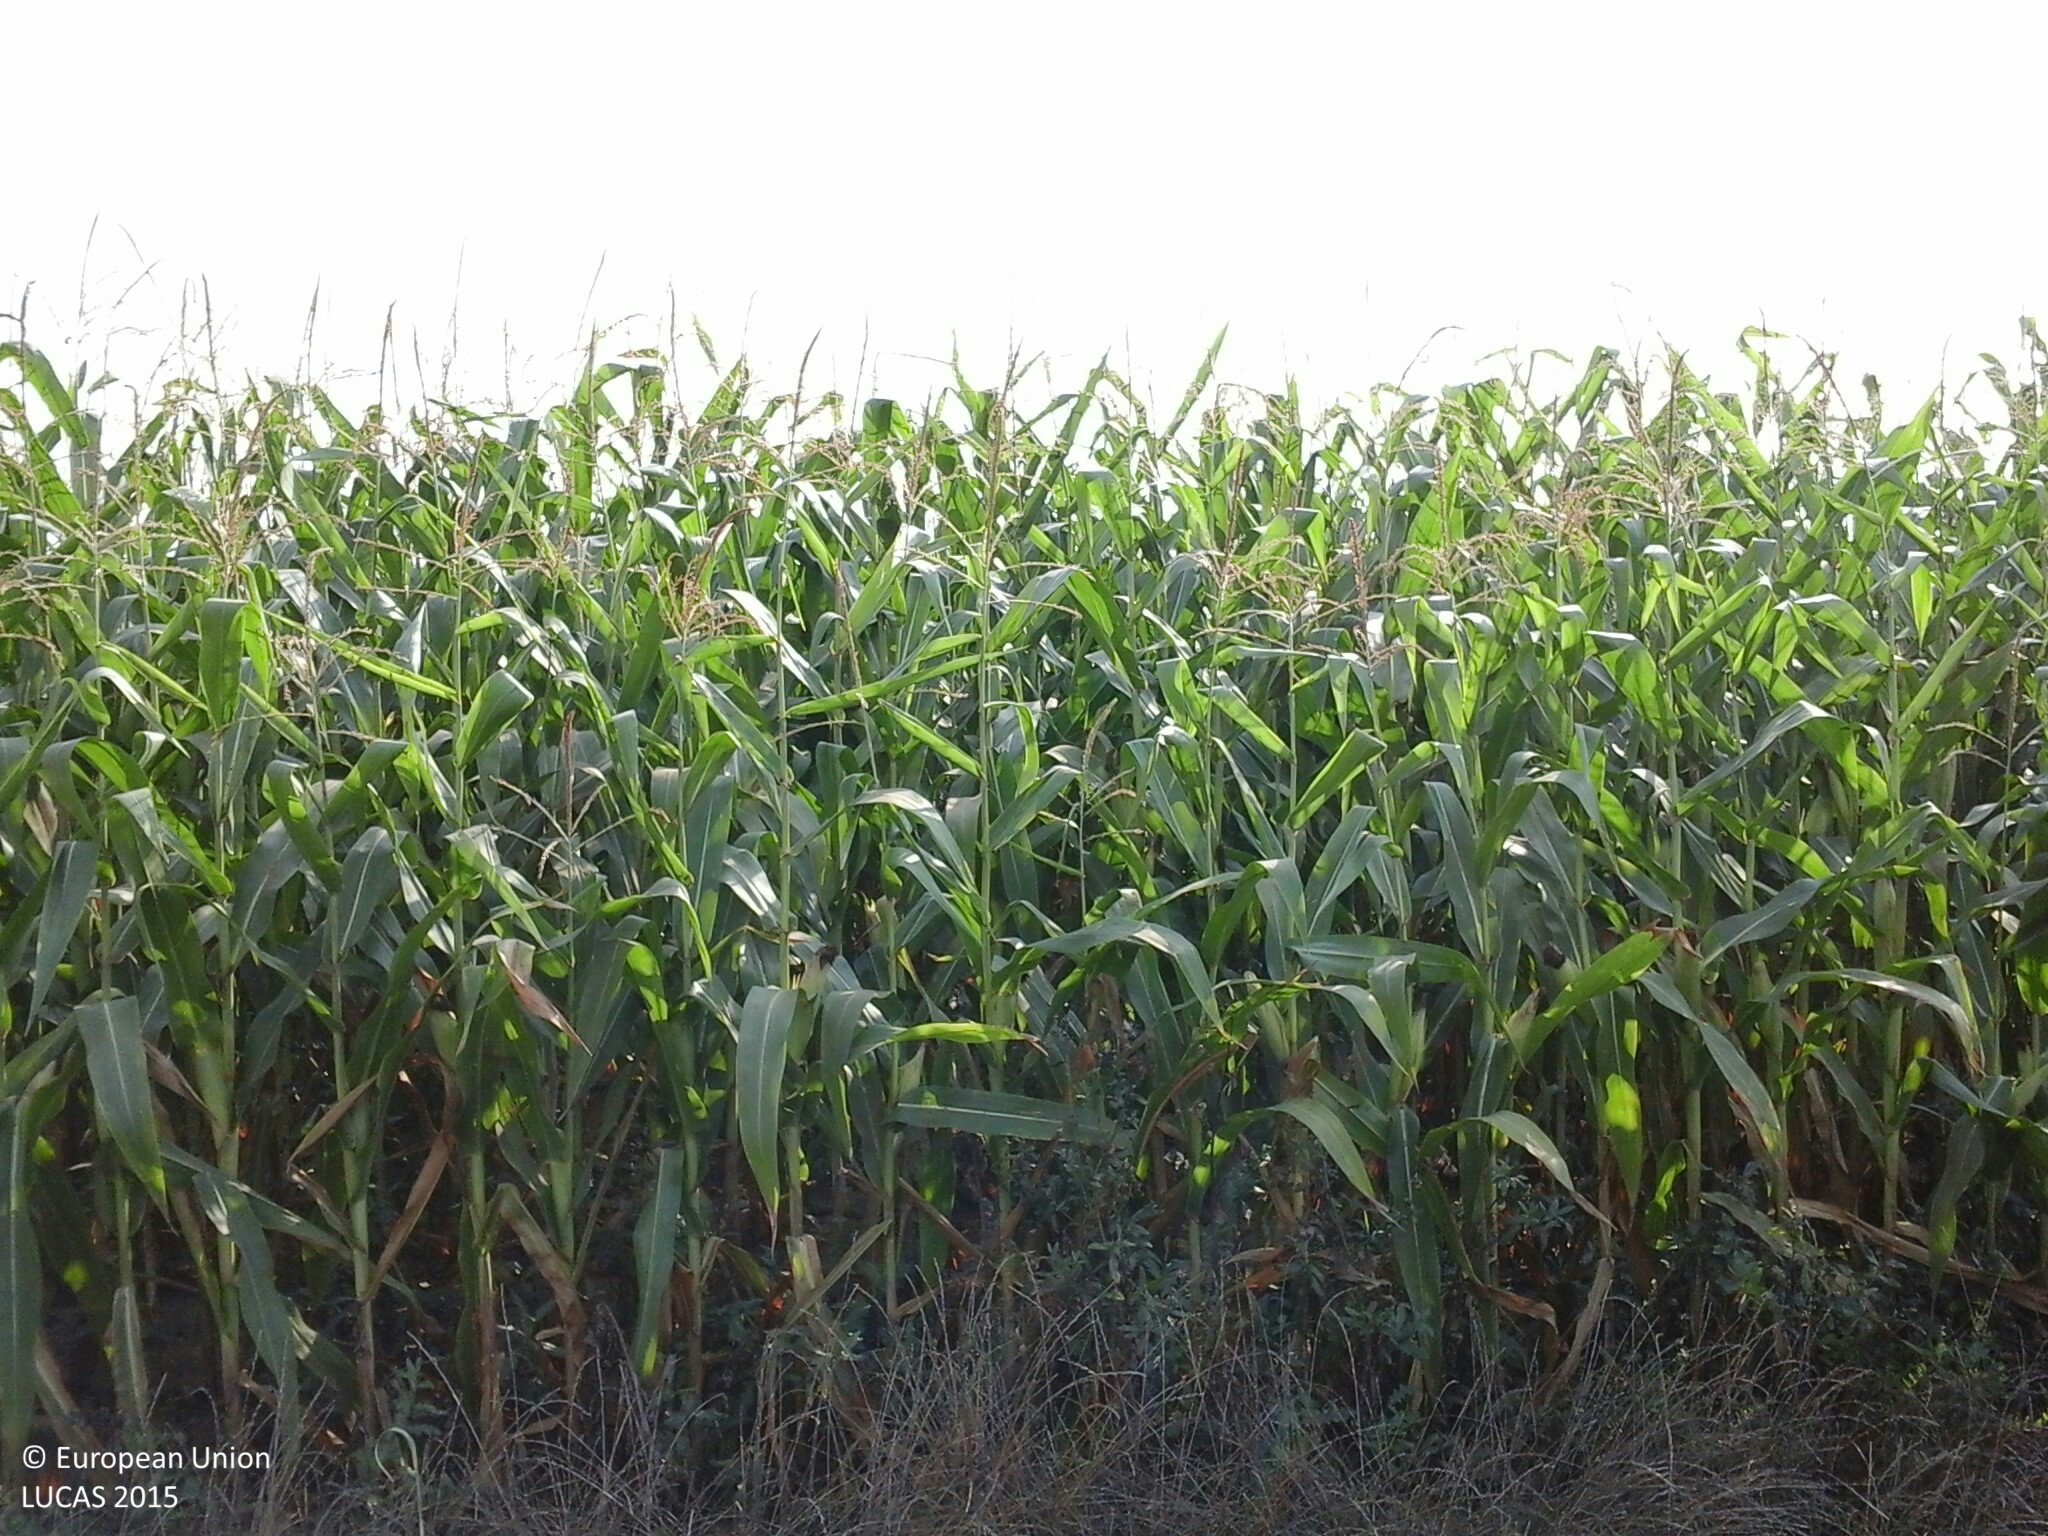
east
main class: Cropland
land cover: Maize
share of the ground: > 75 %
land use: Agriculture (excluding fallow land and kitchen gardens)
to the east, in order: Maize; Grass margins; Tracks; Maize
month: August
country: HU
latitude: 46.6630
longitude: 18.0459
